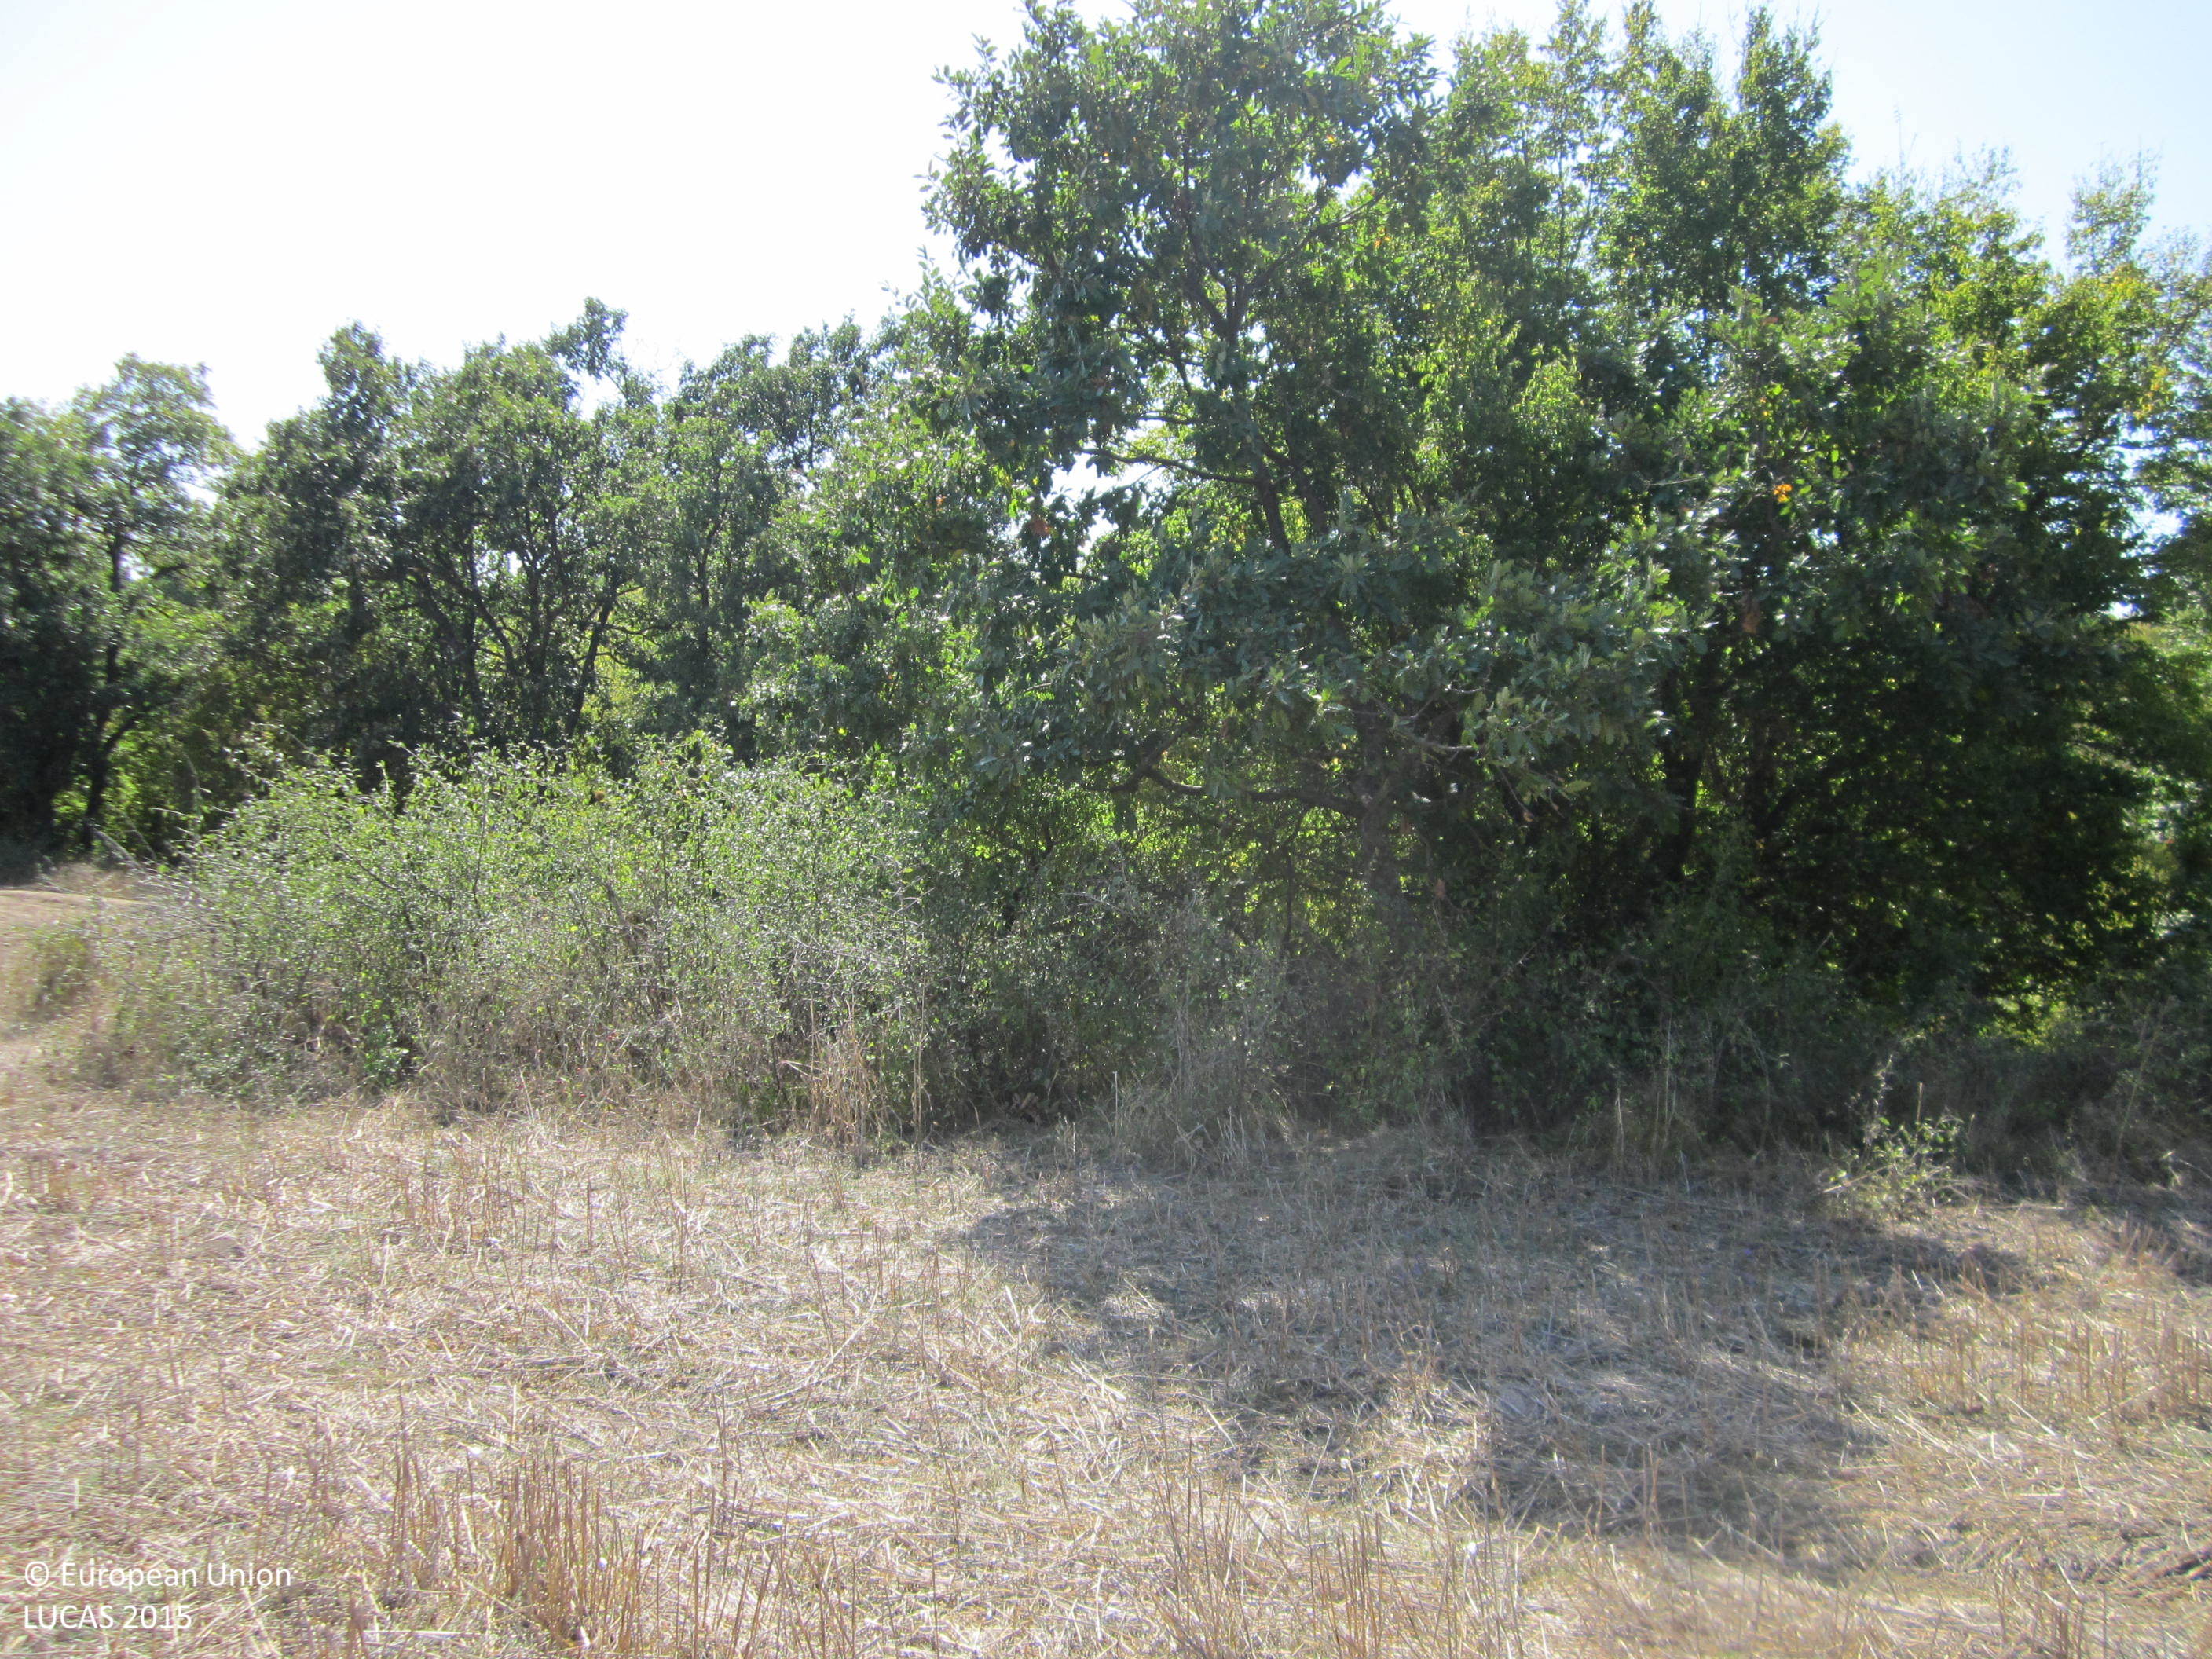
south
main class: Cropland
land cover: Common wheat
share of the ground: 50 - 75 %
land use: Agriculture (excluding fallow land and kitchen gardens)
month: September
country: BG
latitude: 42.7072
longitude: 27.4687
